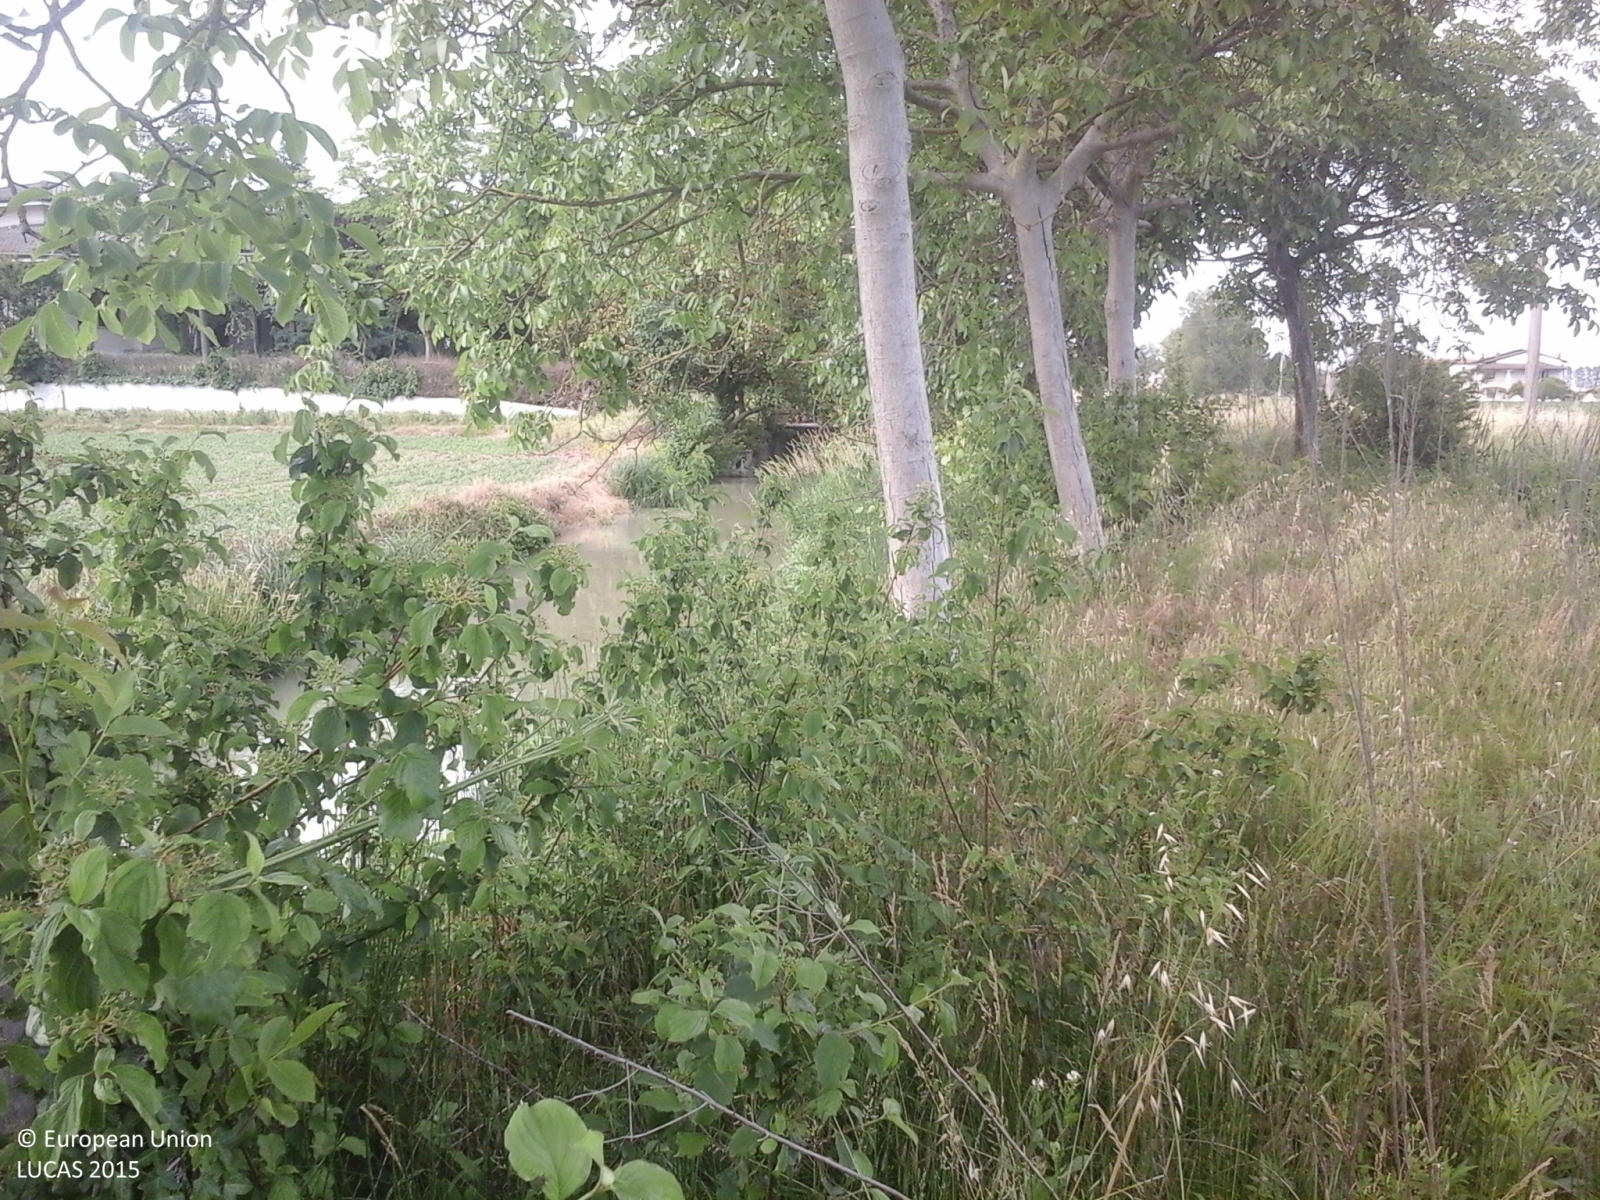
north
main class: Cropland
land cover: Soya
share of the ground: < 10 %
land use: Agriculture (excluding fallow land and kitchen gardens)
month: May
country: IT
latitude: 45.1213
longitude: 10.9770
